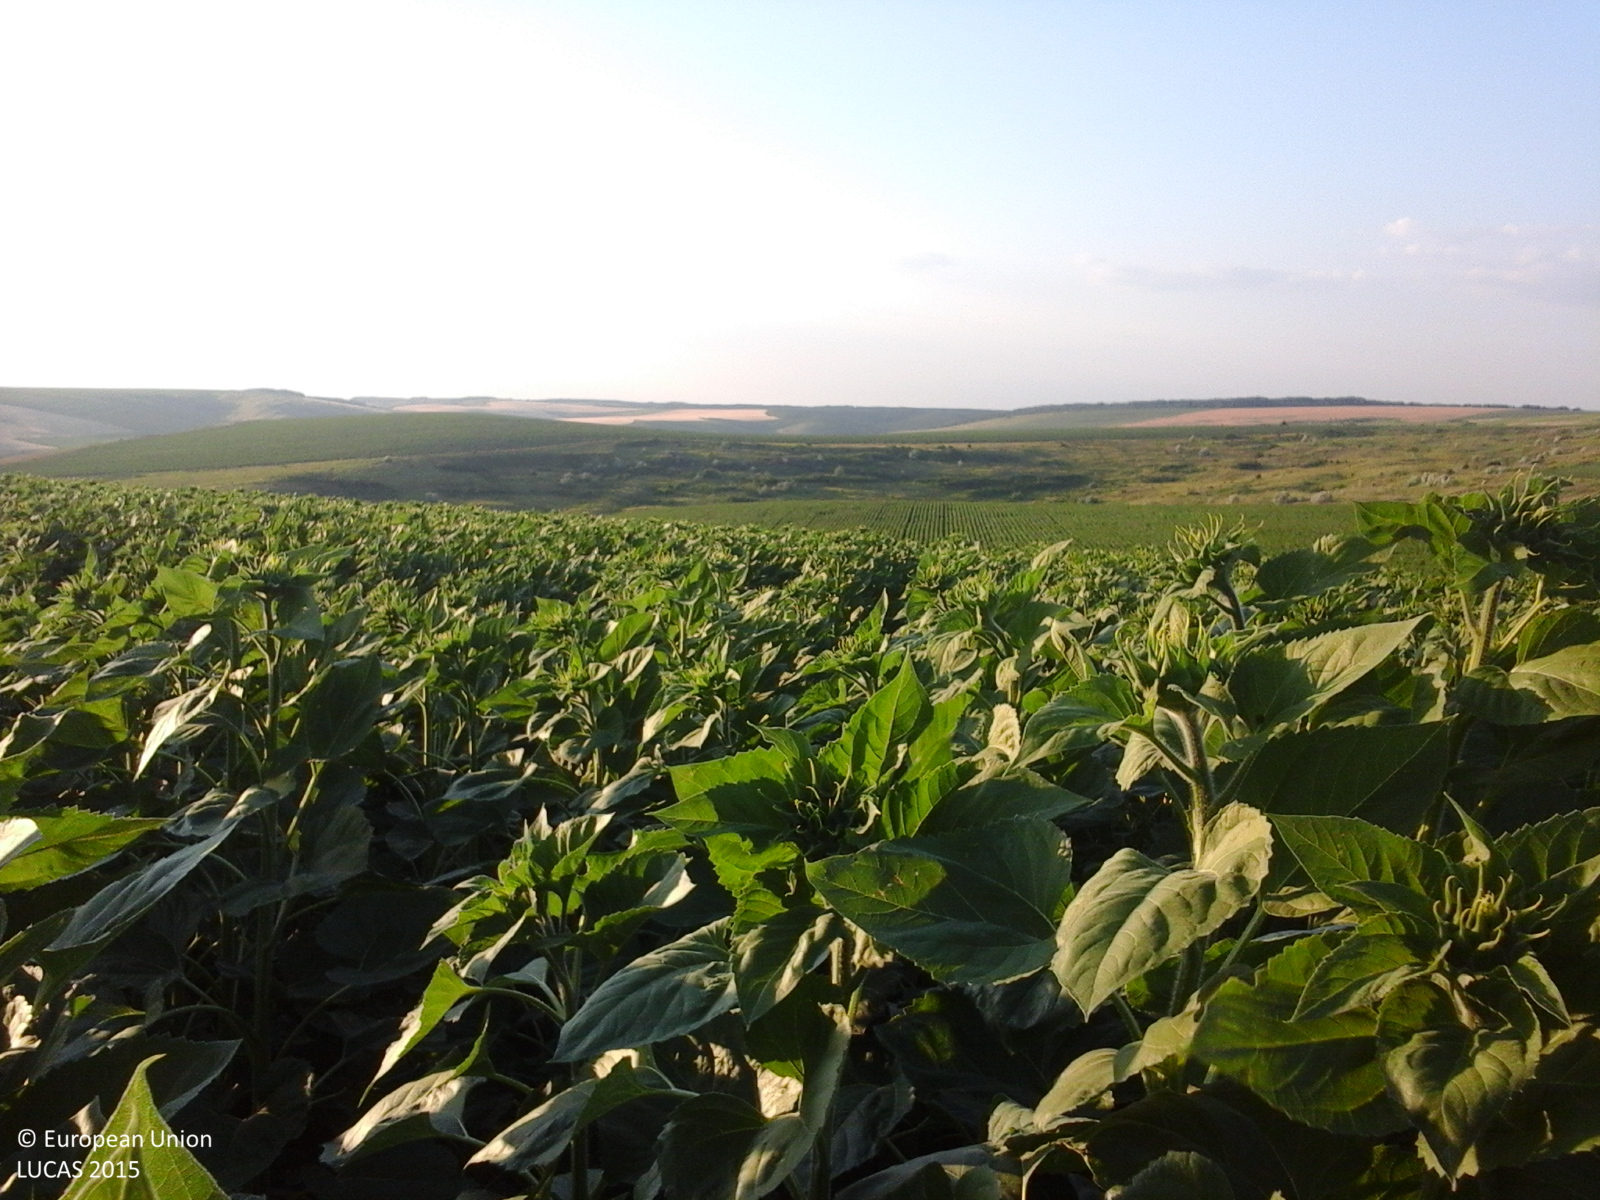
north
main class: Cropland
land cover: Sunflower
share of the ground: > 75 %
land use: Agriculture (excluding fallow land and kitchen gardens)
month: June
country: RO
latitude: 47.3952
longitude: 27.4044
